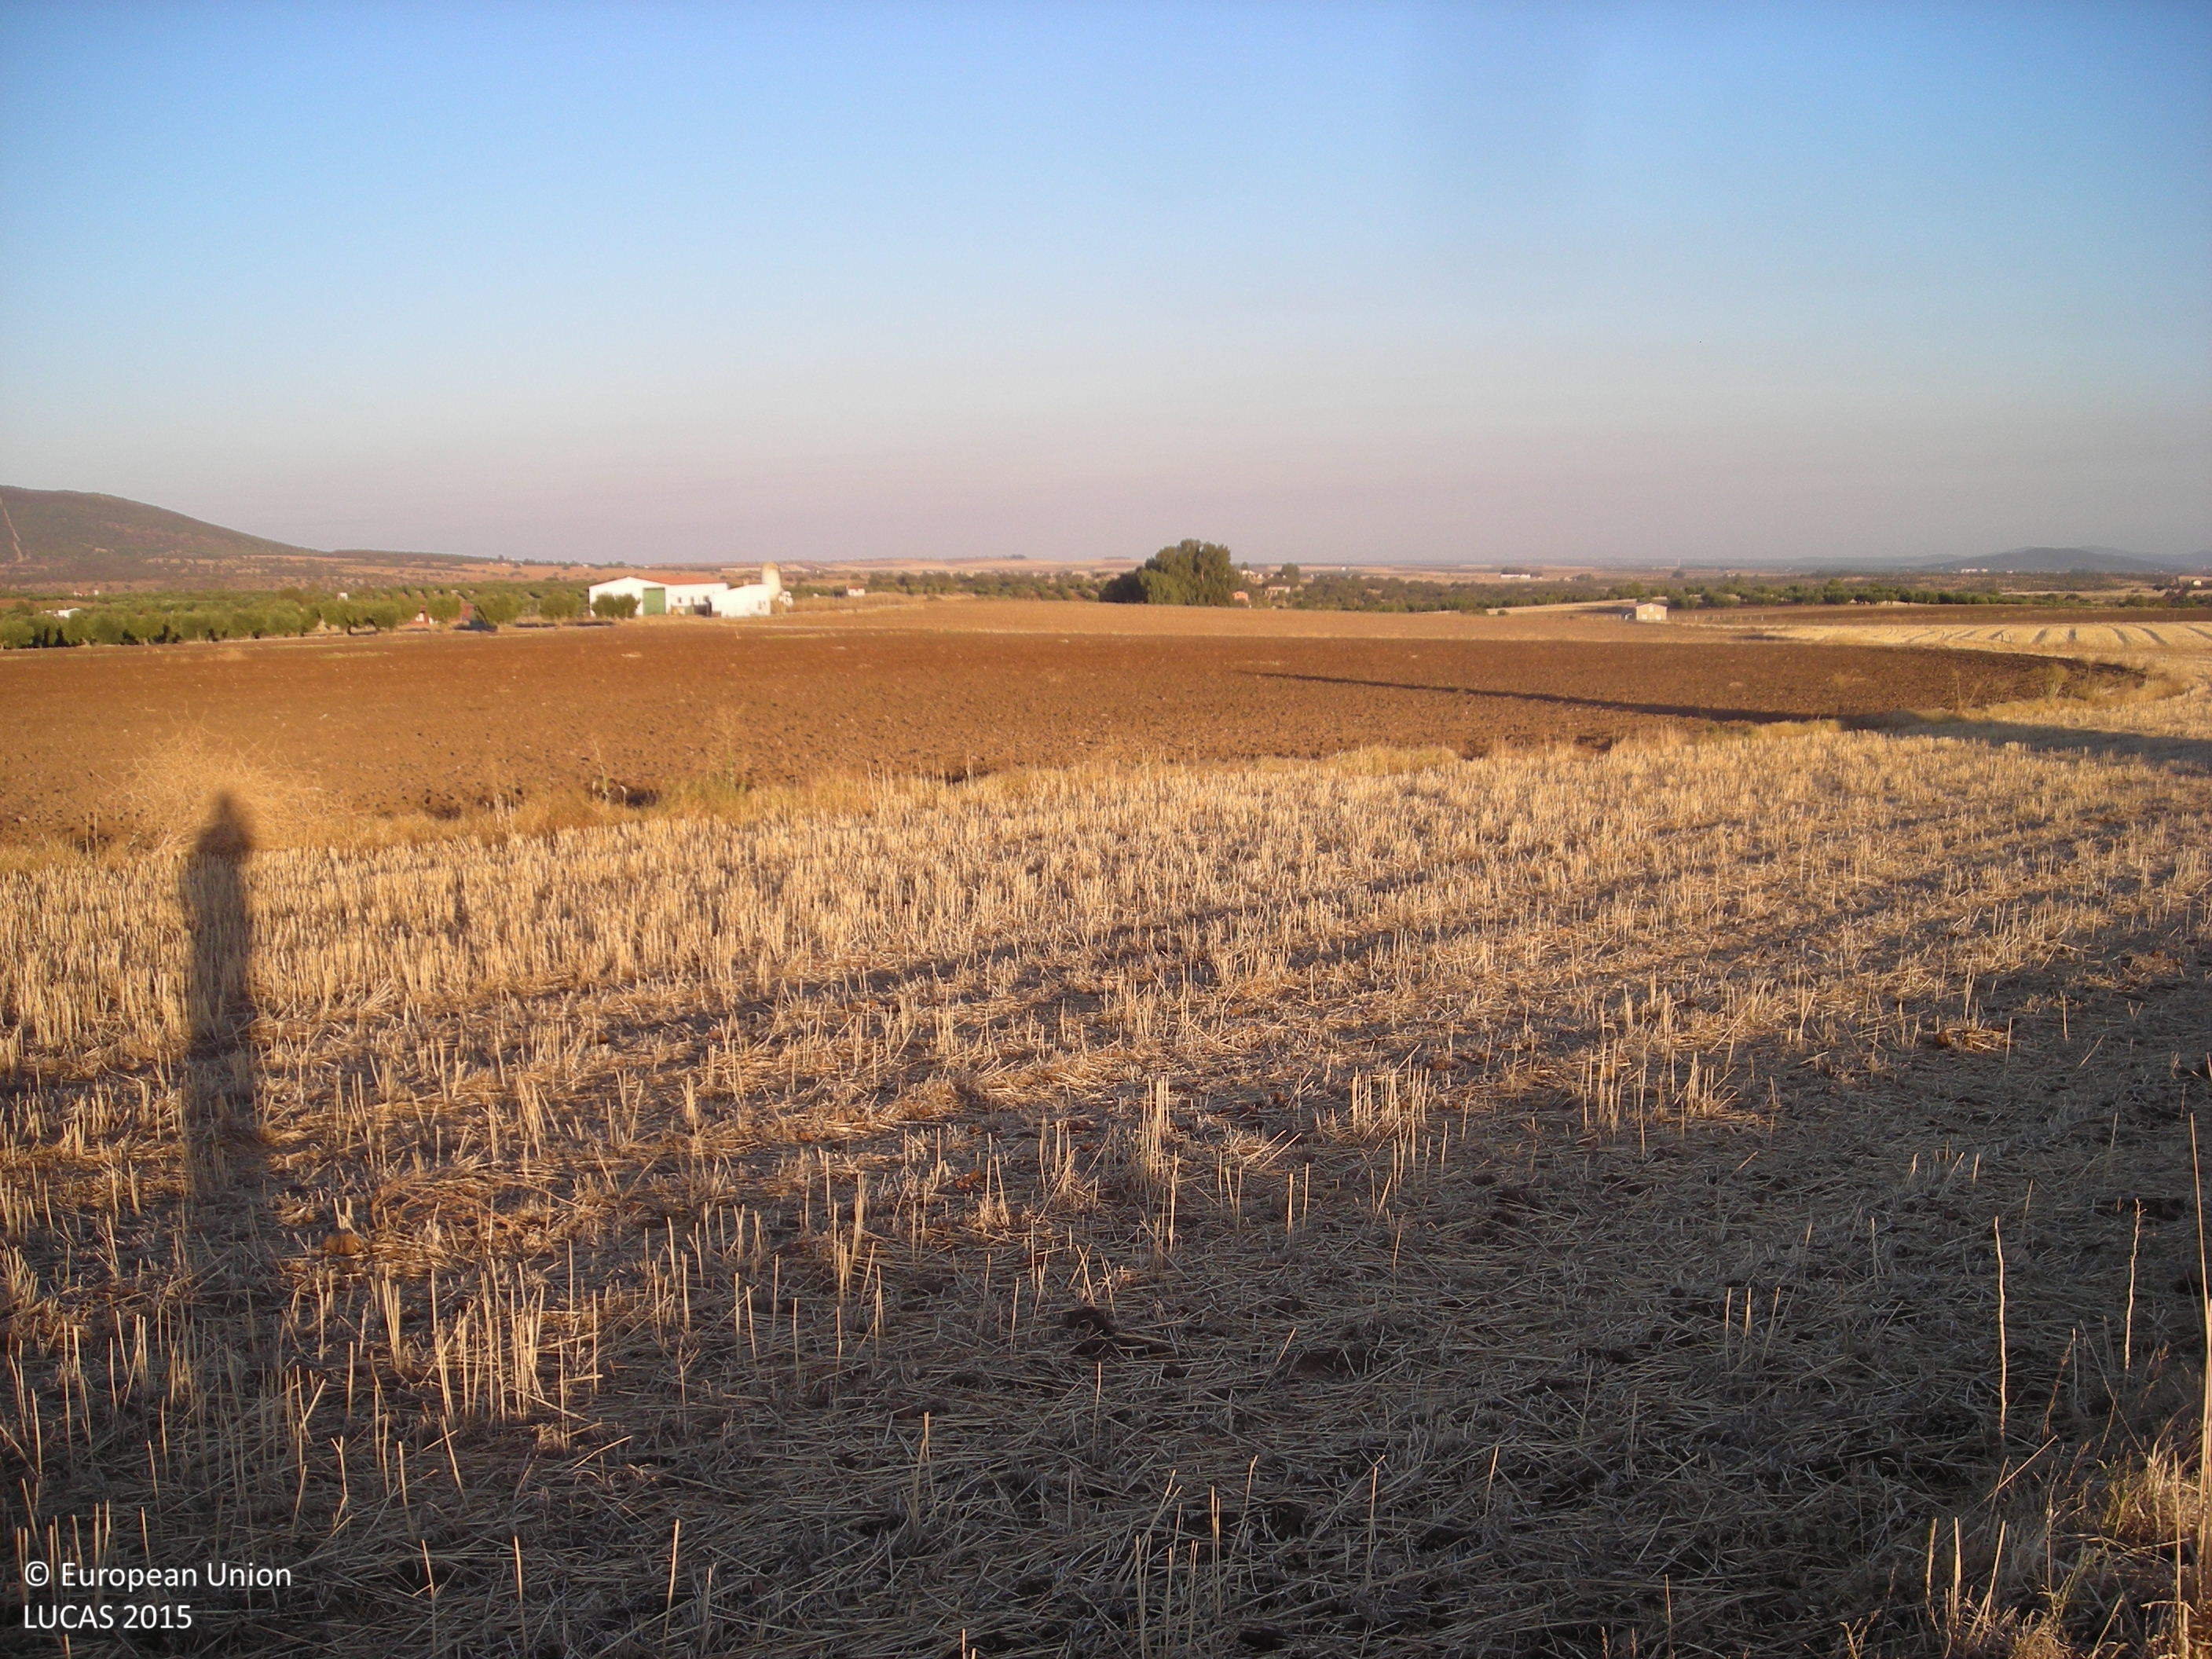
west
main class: Cropland
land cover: Common wheat
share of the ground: > 75 %
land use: Agriculture (excluding fallow land and kitchen gardens)
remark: Harvested field
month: July
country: ES
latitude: 38.9026
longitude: -5.8103
